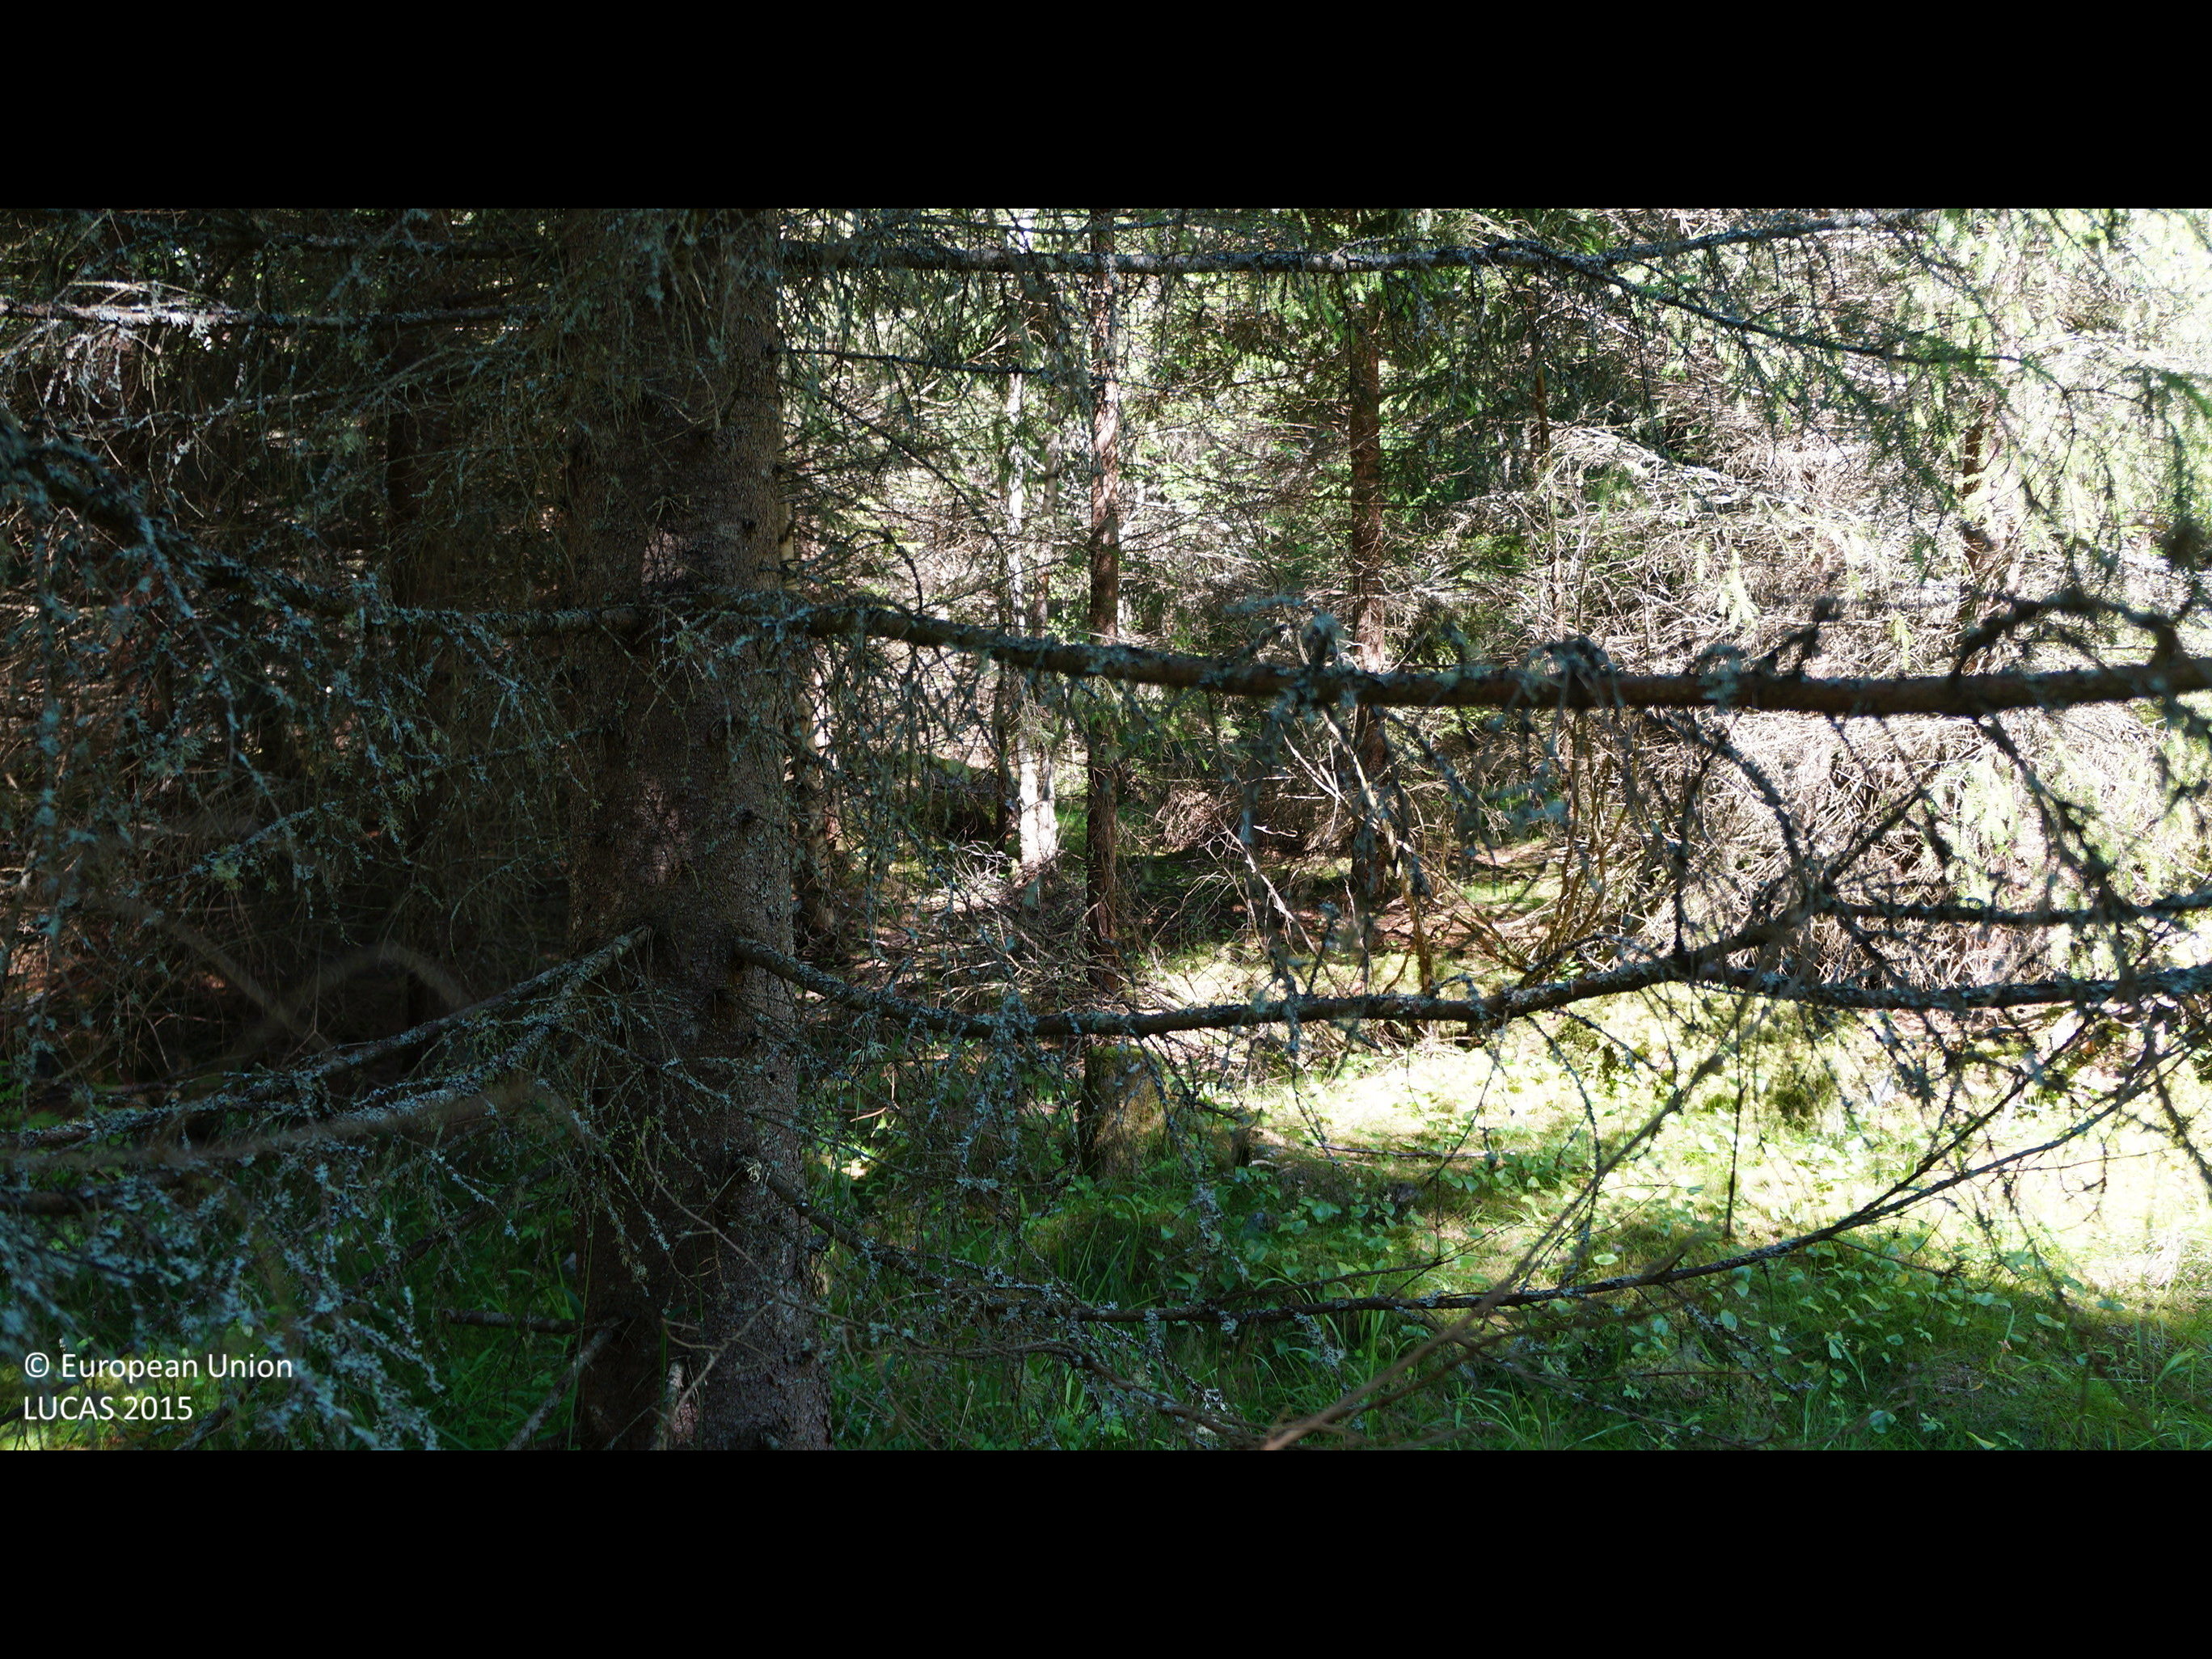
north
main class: Woodland
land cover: Spruce dominated mixed woodland
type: boreal forest
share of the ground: 50 - 75 %
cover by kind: coniferous forest trees 40 %, broadleaved forest trees 30 %, herbaceous plants 15 %, shrubs 10 %, lichens and mosses 5 %
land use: Forestry
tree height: > 5 m
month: July
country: FI
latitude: 63.8312
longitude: 22.9145
